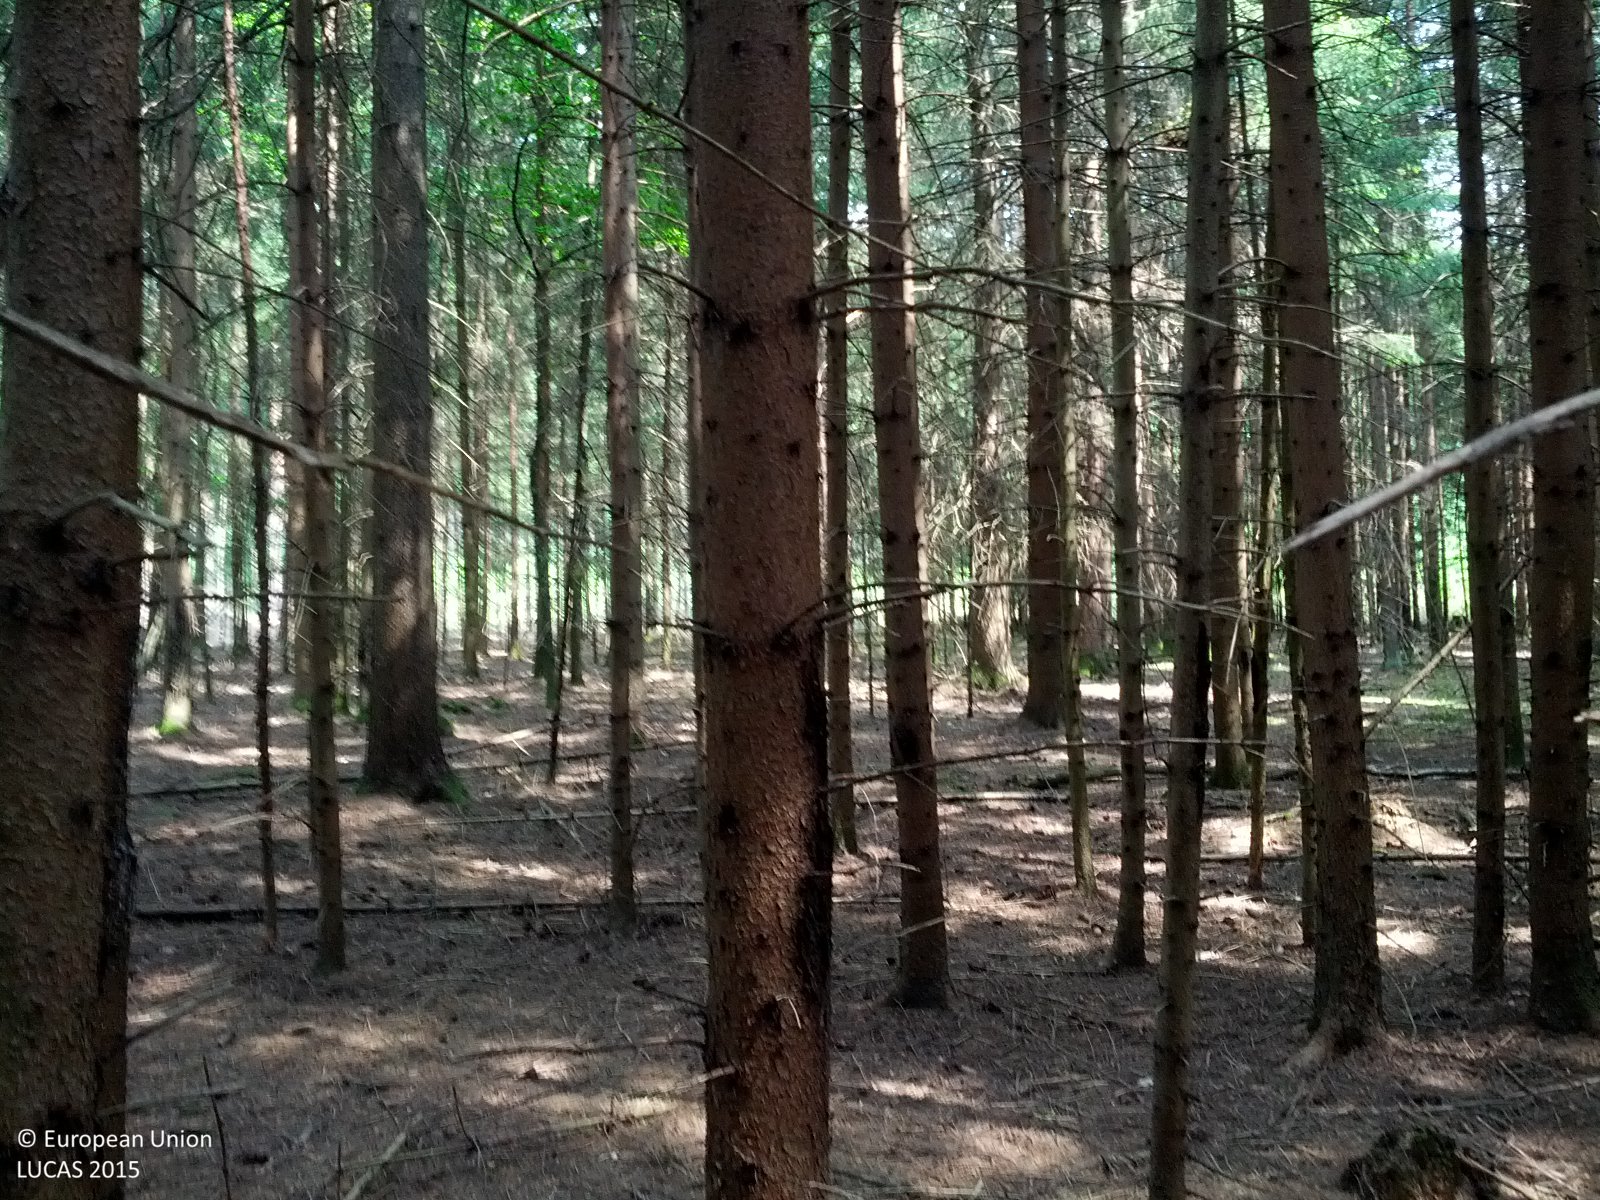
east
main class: Woodland
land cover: Spruce dominated coniferous woodland
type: boreal forest
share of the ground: > 75 %
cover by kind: coniferous forest trees 70 %, unconsolidated bare surface 30 %
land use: Forestry
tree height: > 5 m
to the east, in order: Spruce dominated coniferous woodland; Tracks; Spruce dominated coniferous woodland; Spruce dominated mixed woodland; Spruce dominated coniferous woodland; Shrubland with sparse tree cover; Tracks; Pine dominated mixed woodland
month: May
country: AT
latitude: 47.3116
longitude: 16.1533
